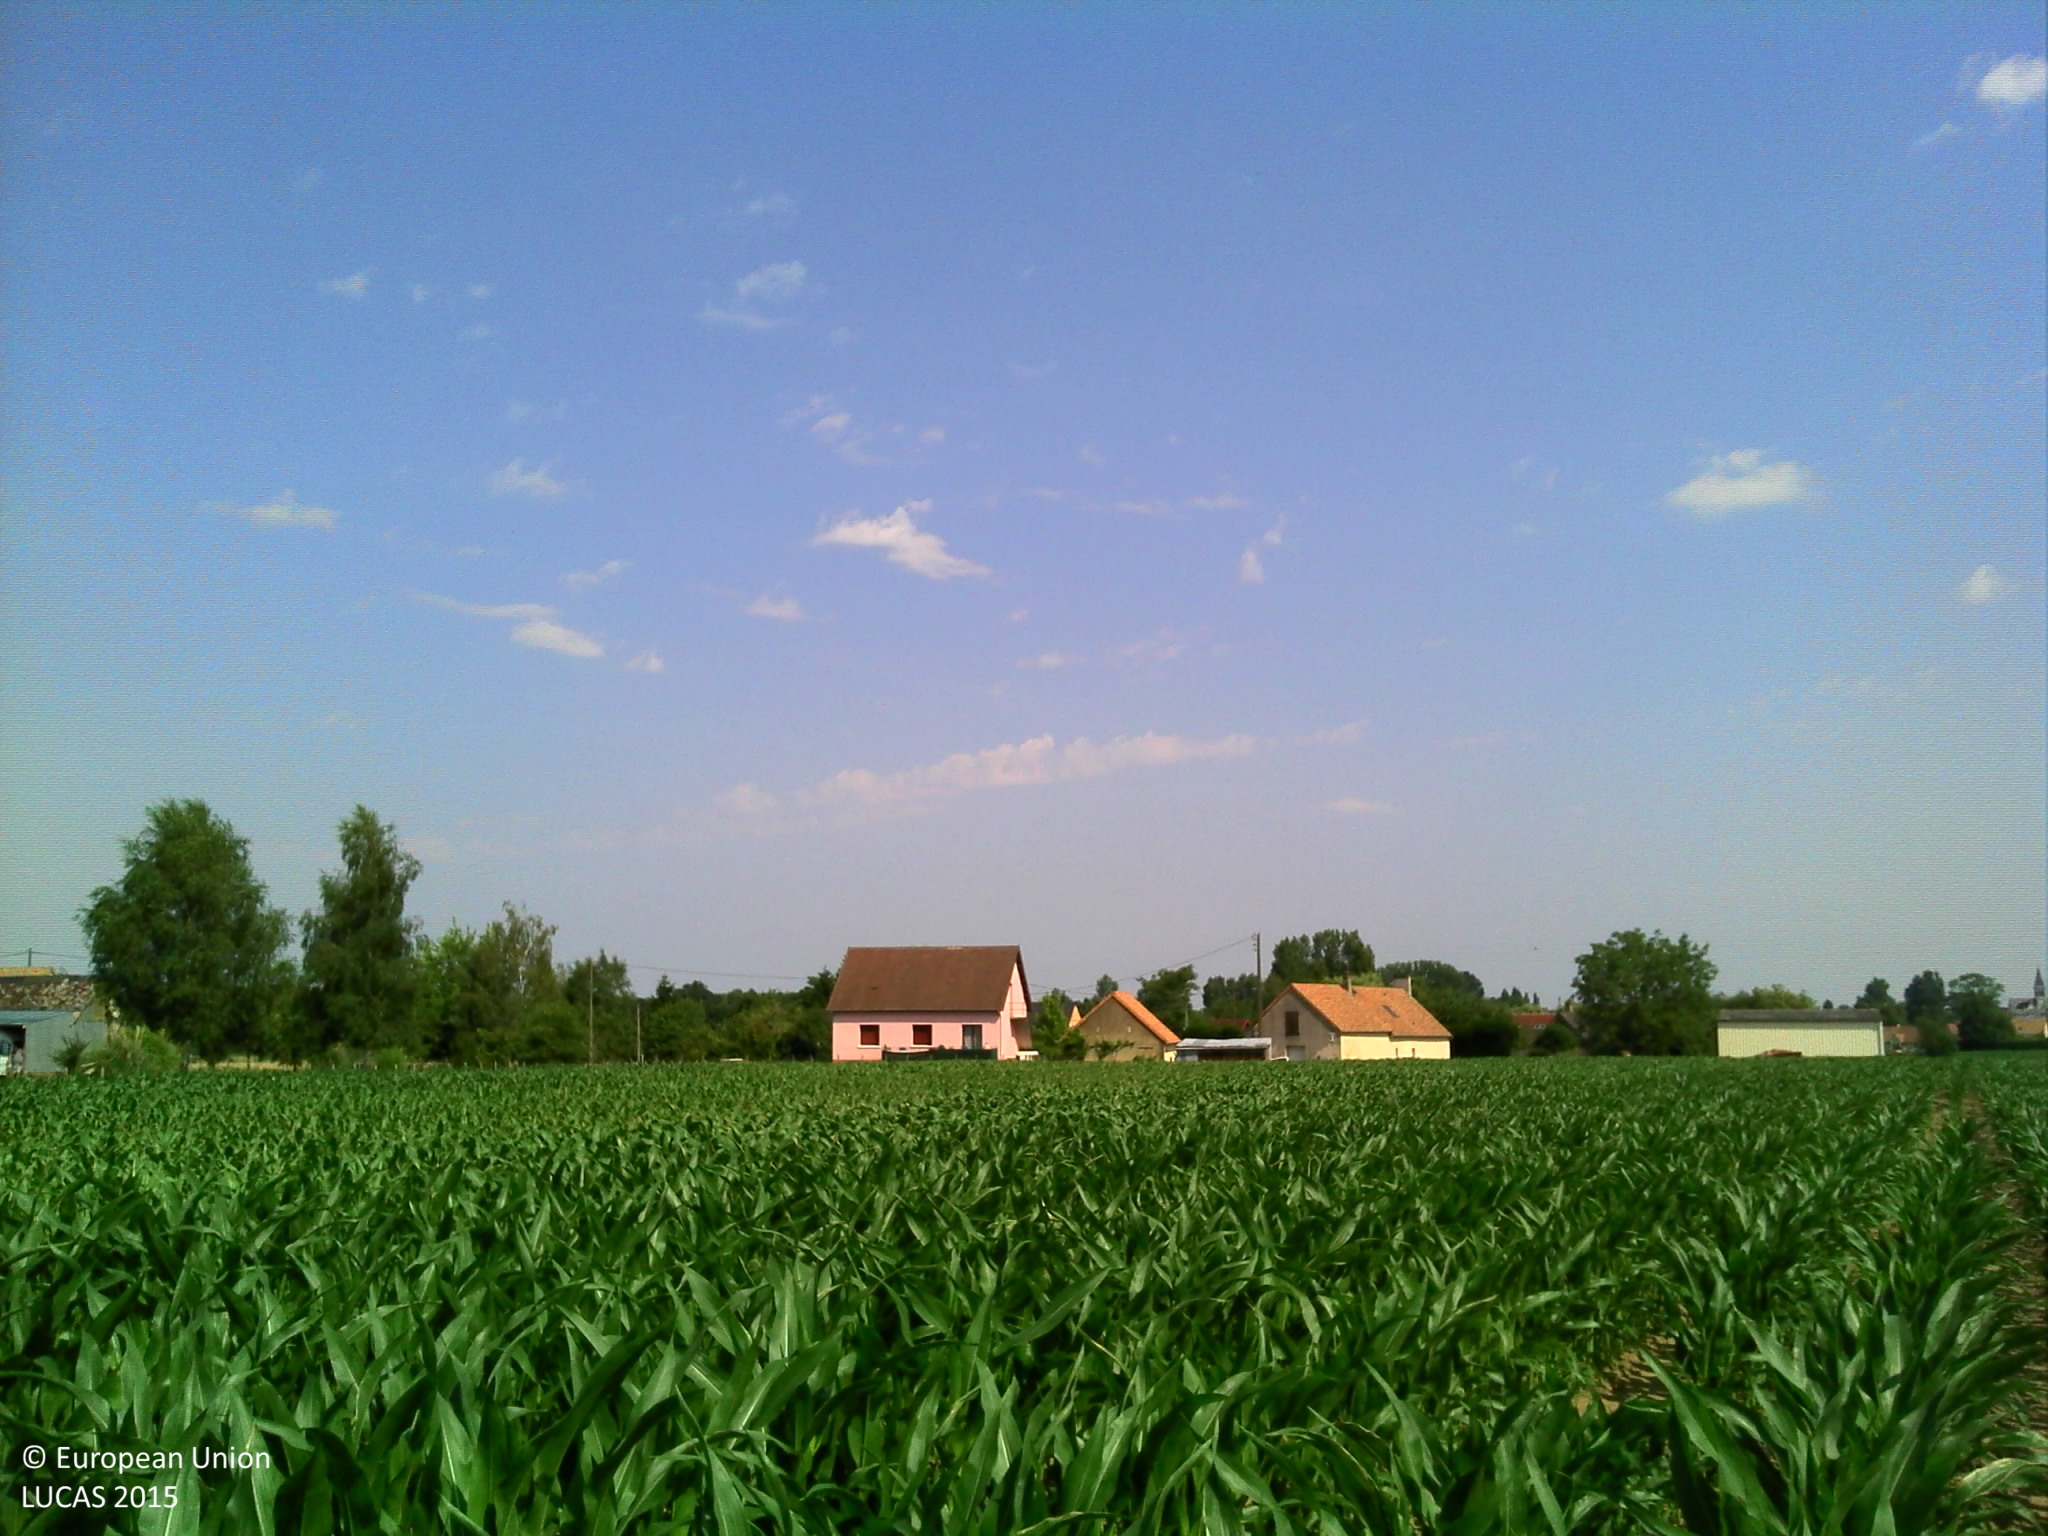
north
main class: Cropland
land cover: Maize
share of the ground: > 75 %
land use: Agriculture (excluding fallow land and kitchen gardens)
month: July
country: FR
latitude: 47.8231
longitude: 0.2107
